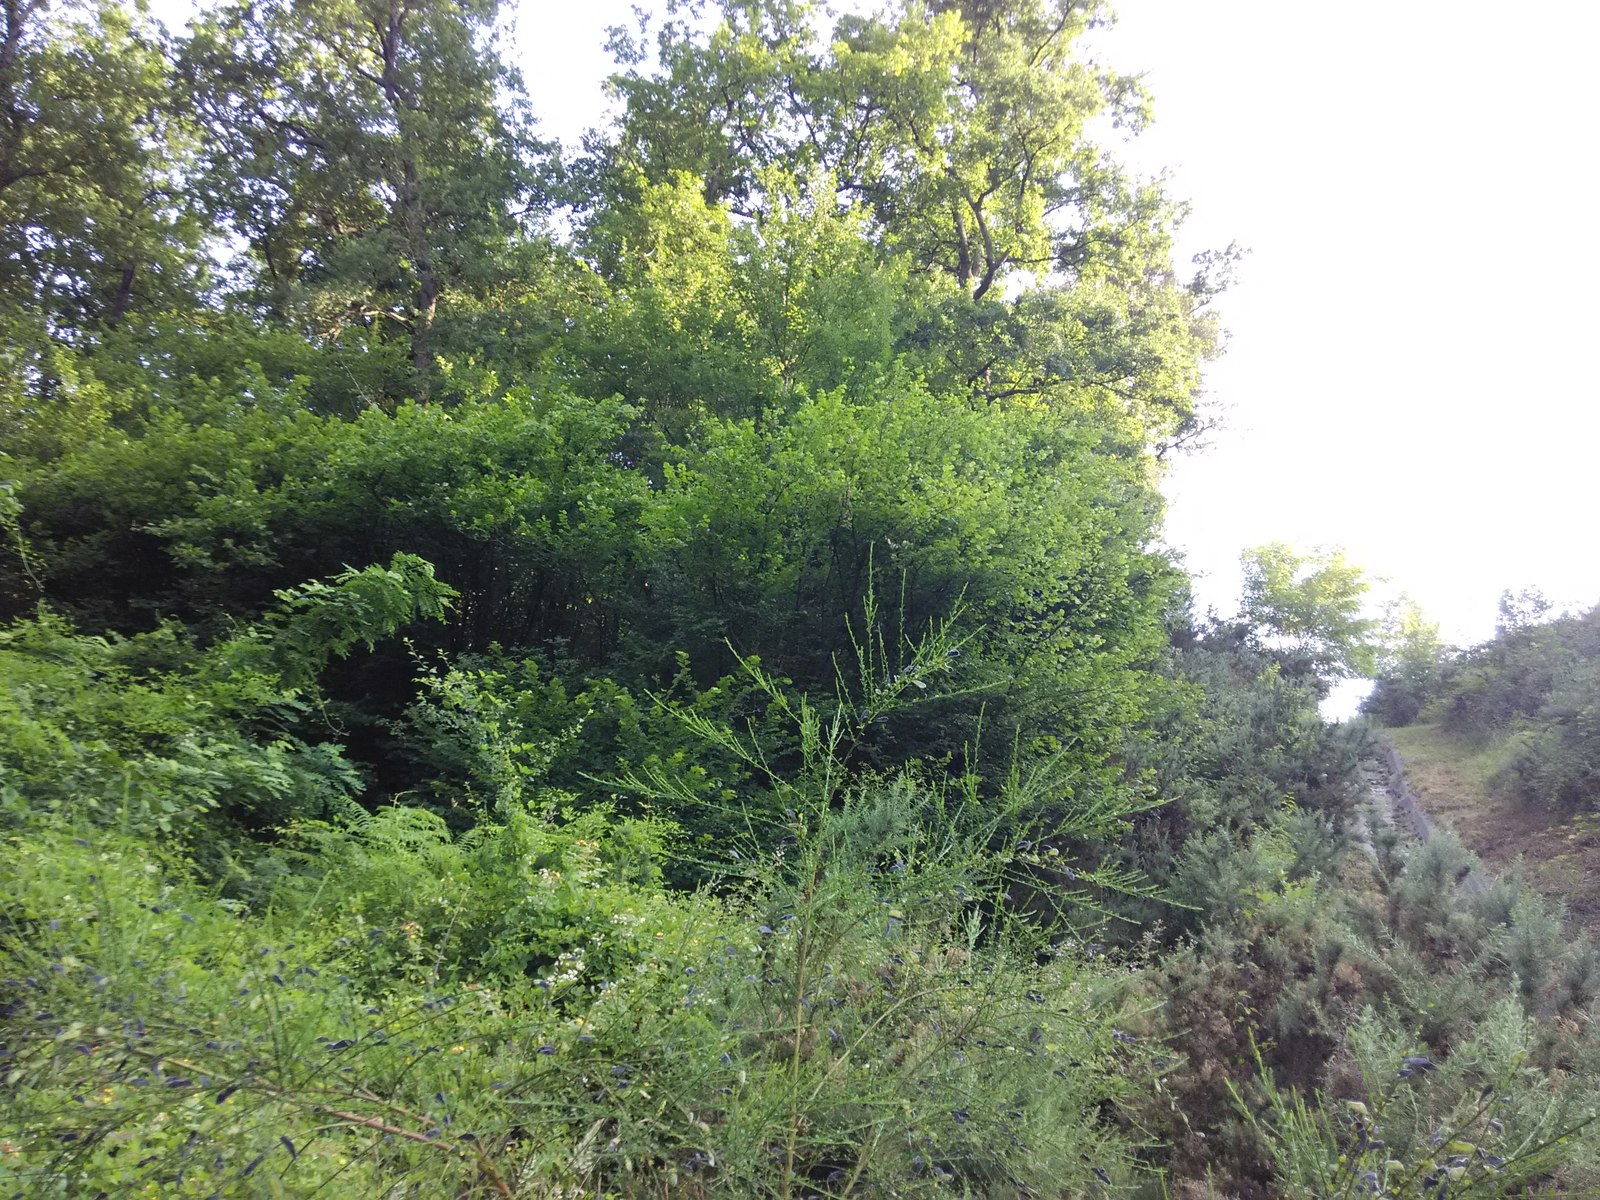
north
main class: Woodland
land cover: Broadleaved woodland
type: acidophilous oak and oak-birch forest
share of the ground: > 75 %
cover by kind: broadleaved forest trees 100 %
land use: Forestry
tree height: > 5 m
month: July
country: ES
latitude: 43.0697
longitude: -2.2924
